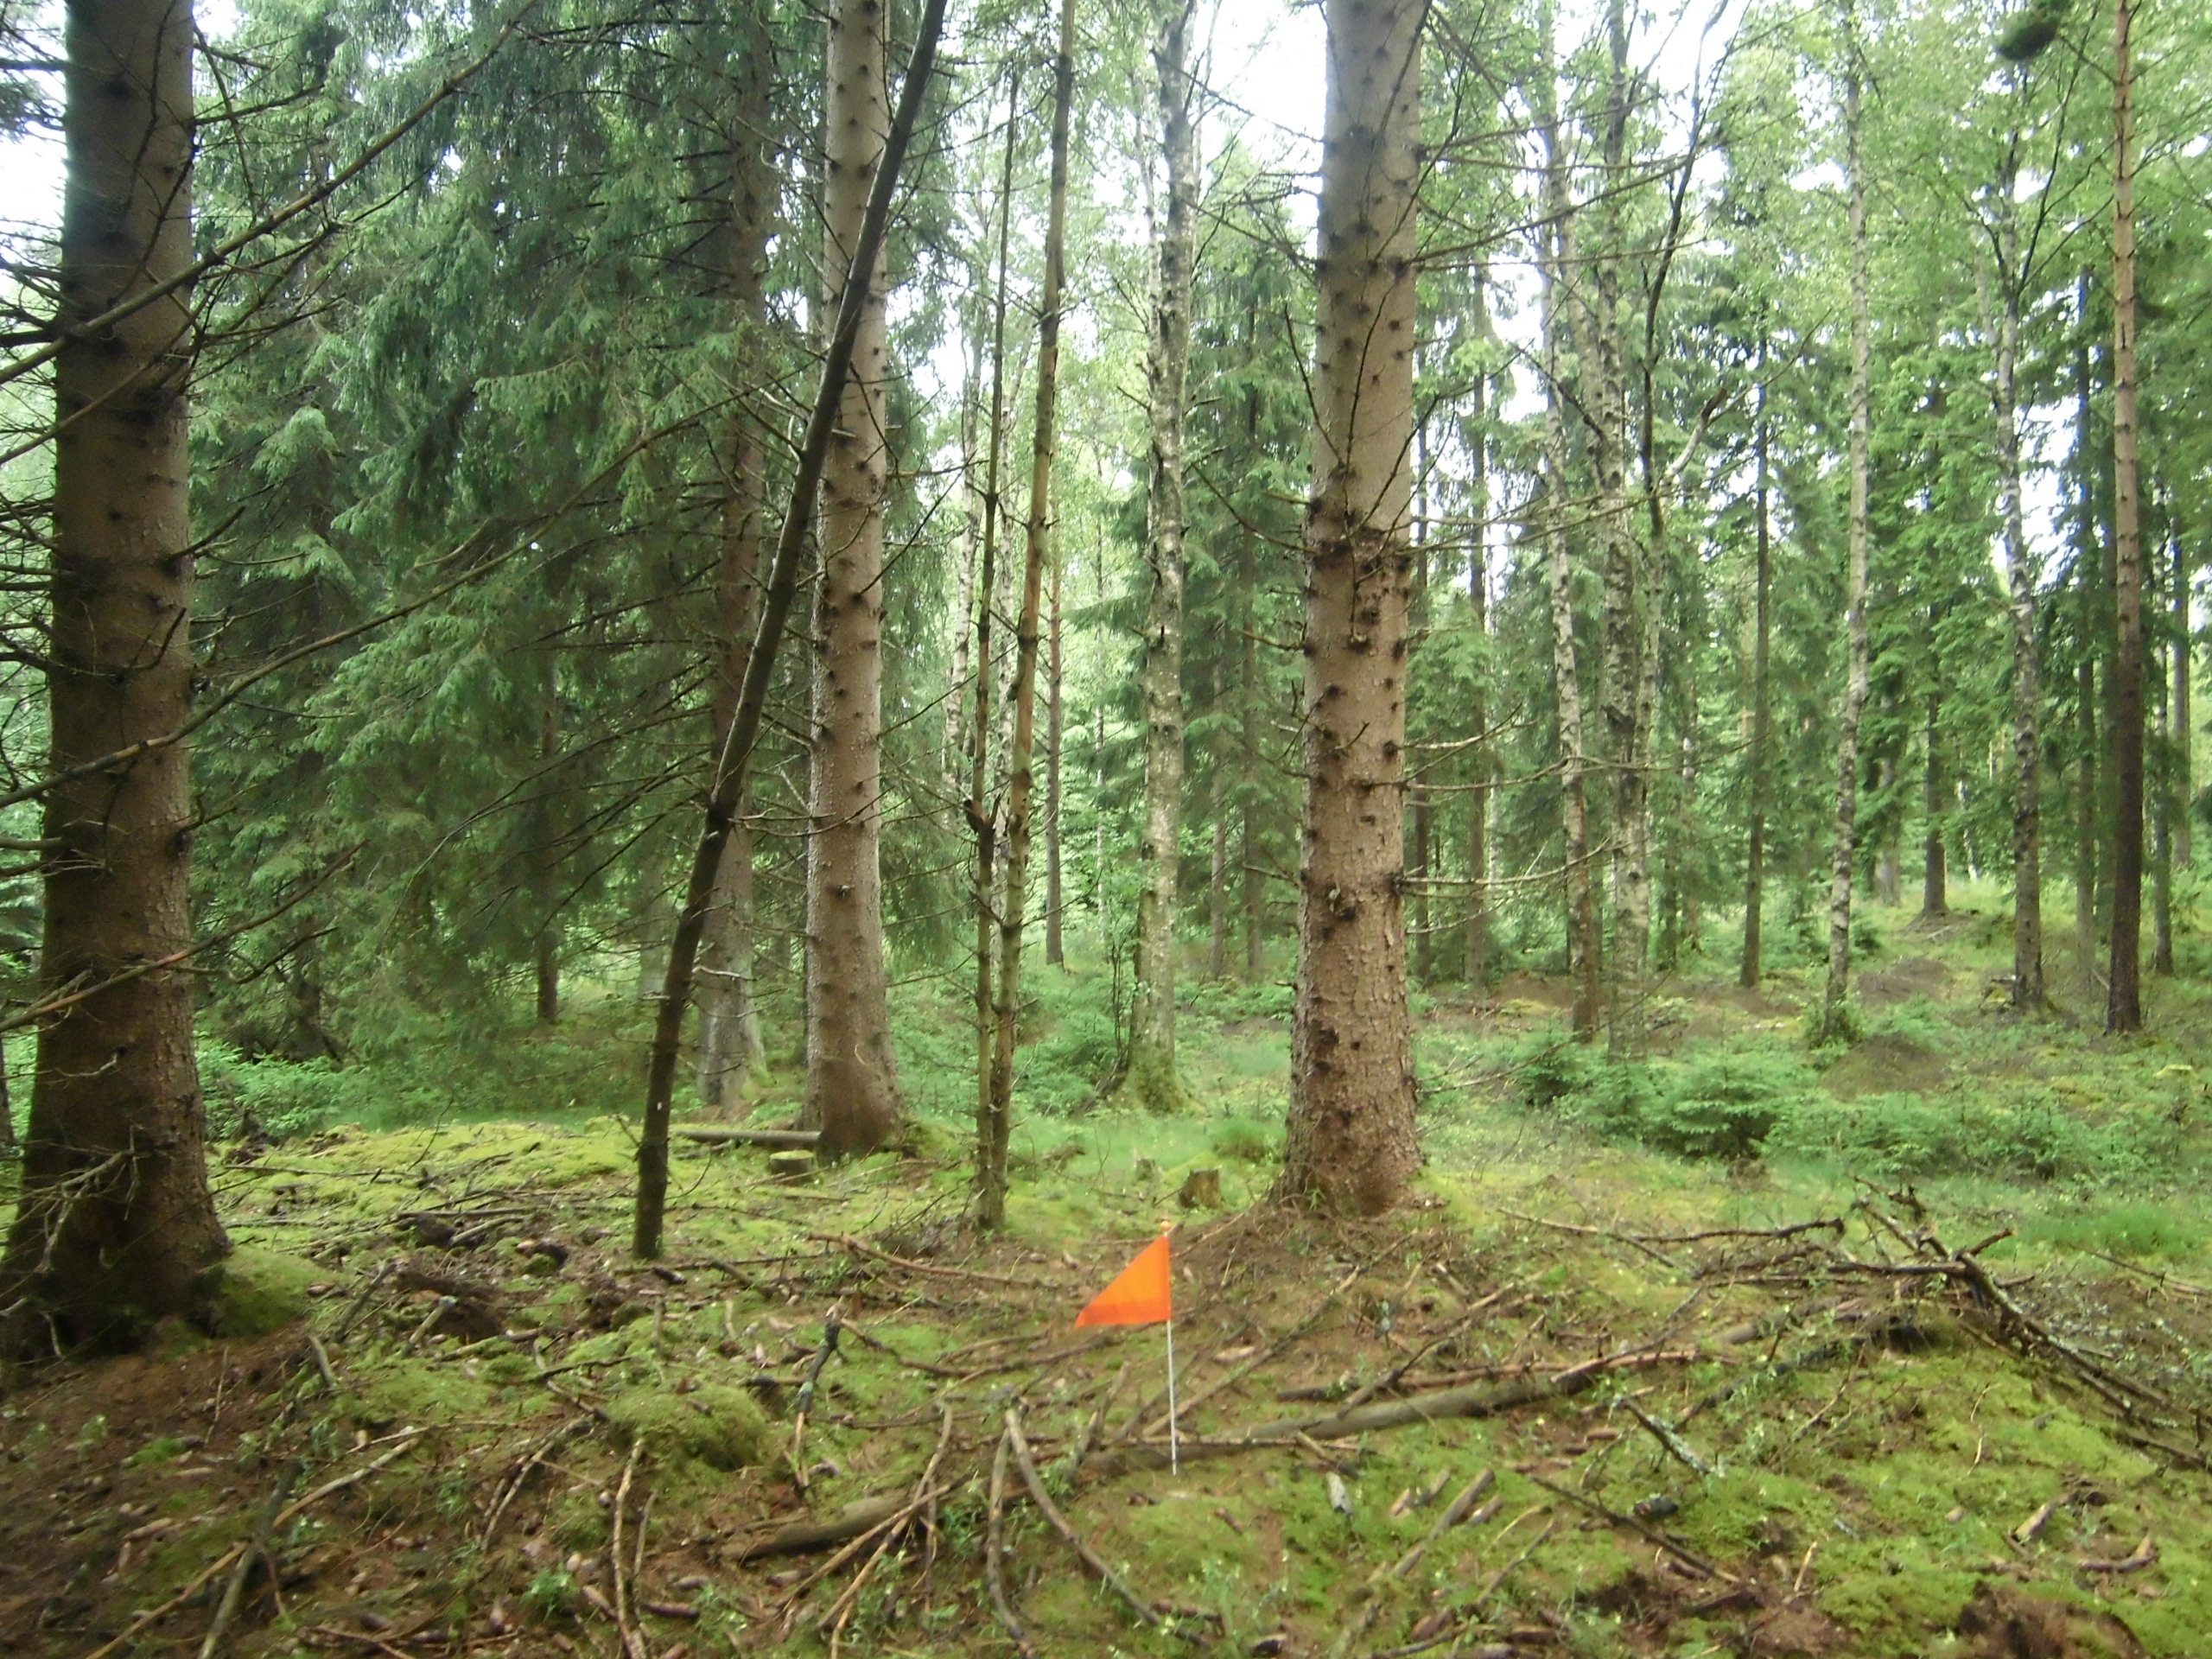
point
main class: Woodland
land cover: Spruce dominated coniferous woodland
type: boreal forest
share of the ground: 50 - 75 %
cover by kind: coniferous forest trees 60 %, lichens and mosses 20 %, herbaceous plants 10 %, broadleaved forest trees 5 %, shrubs 5 %
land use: Forestry
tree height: > 5 m
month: July
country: SE
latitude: 57.1236
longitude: 15.2994
